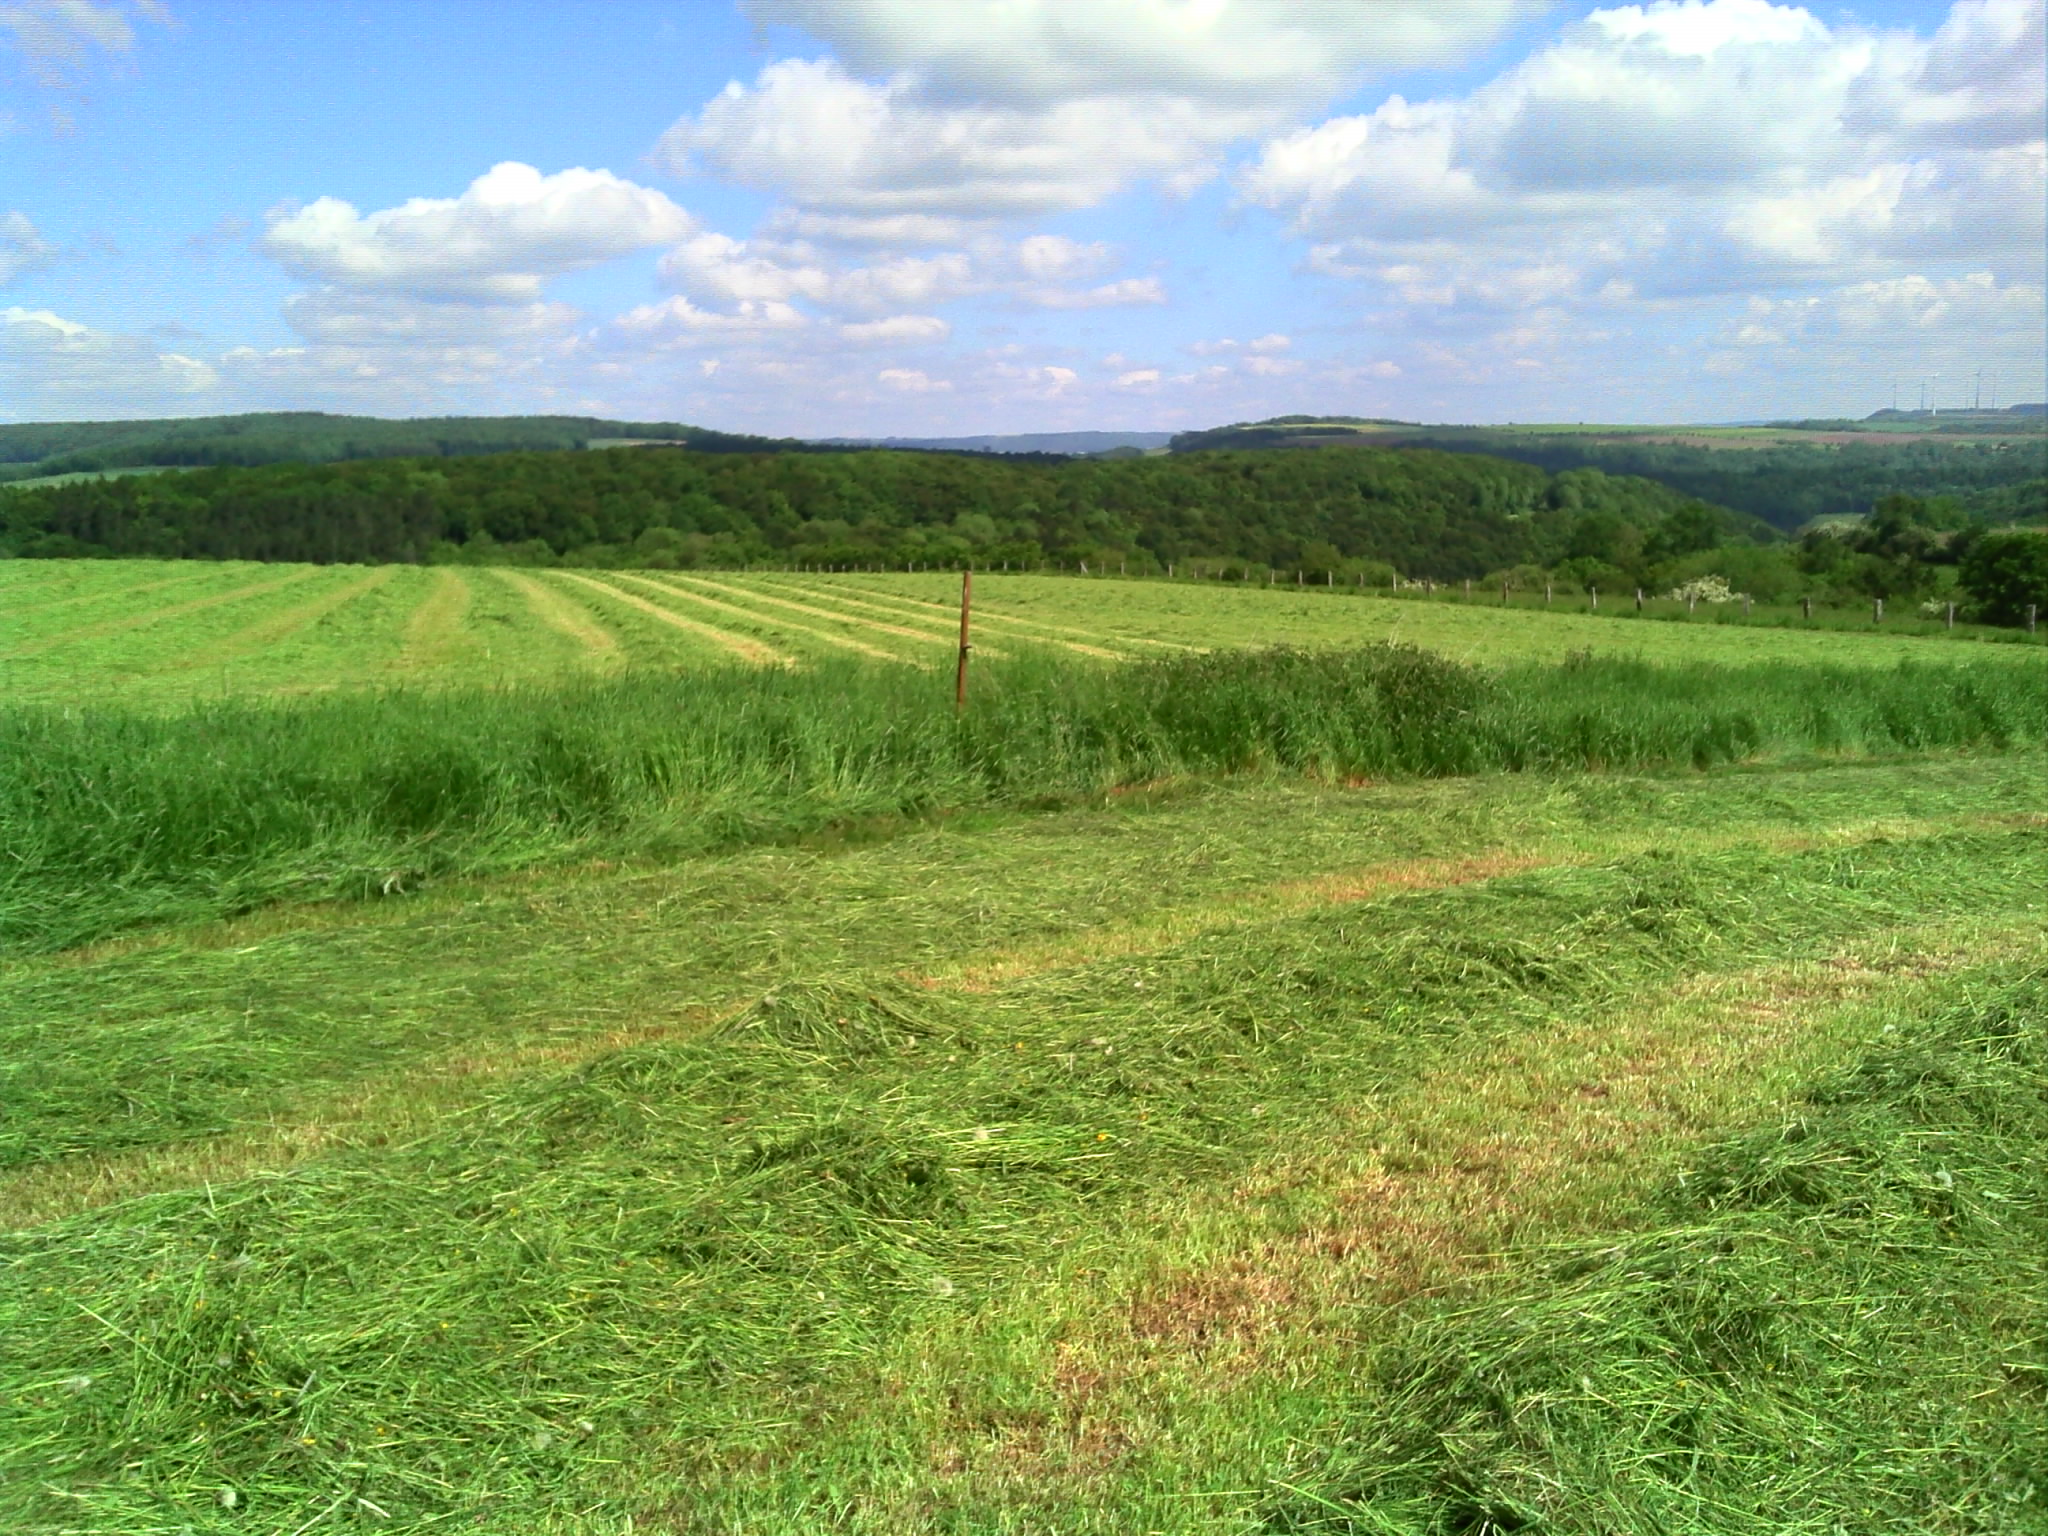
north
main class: Grassland
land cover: Grassland without tree/shrub cover
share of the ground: > 75 %
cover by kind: herbaceous plants 100 %
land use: Agriculture (excluding fallow land and kitchen gardens)
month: May
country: LU
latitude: 49.8528
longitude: 6.2581
